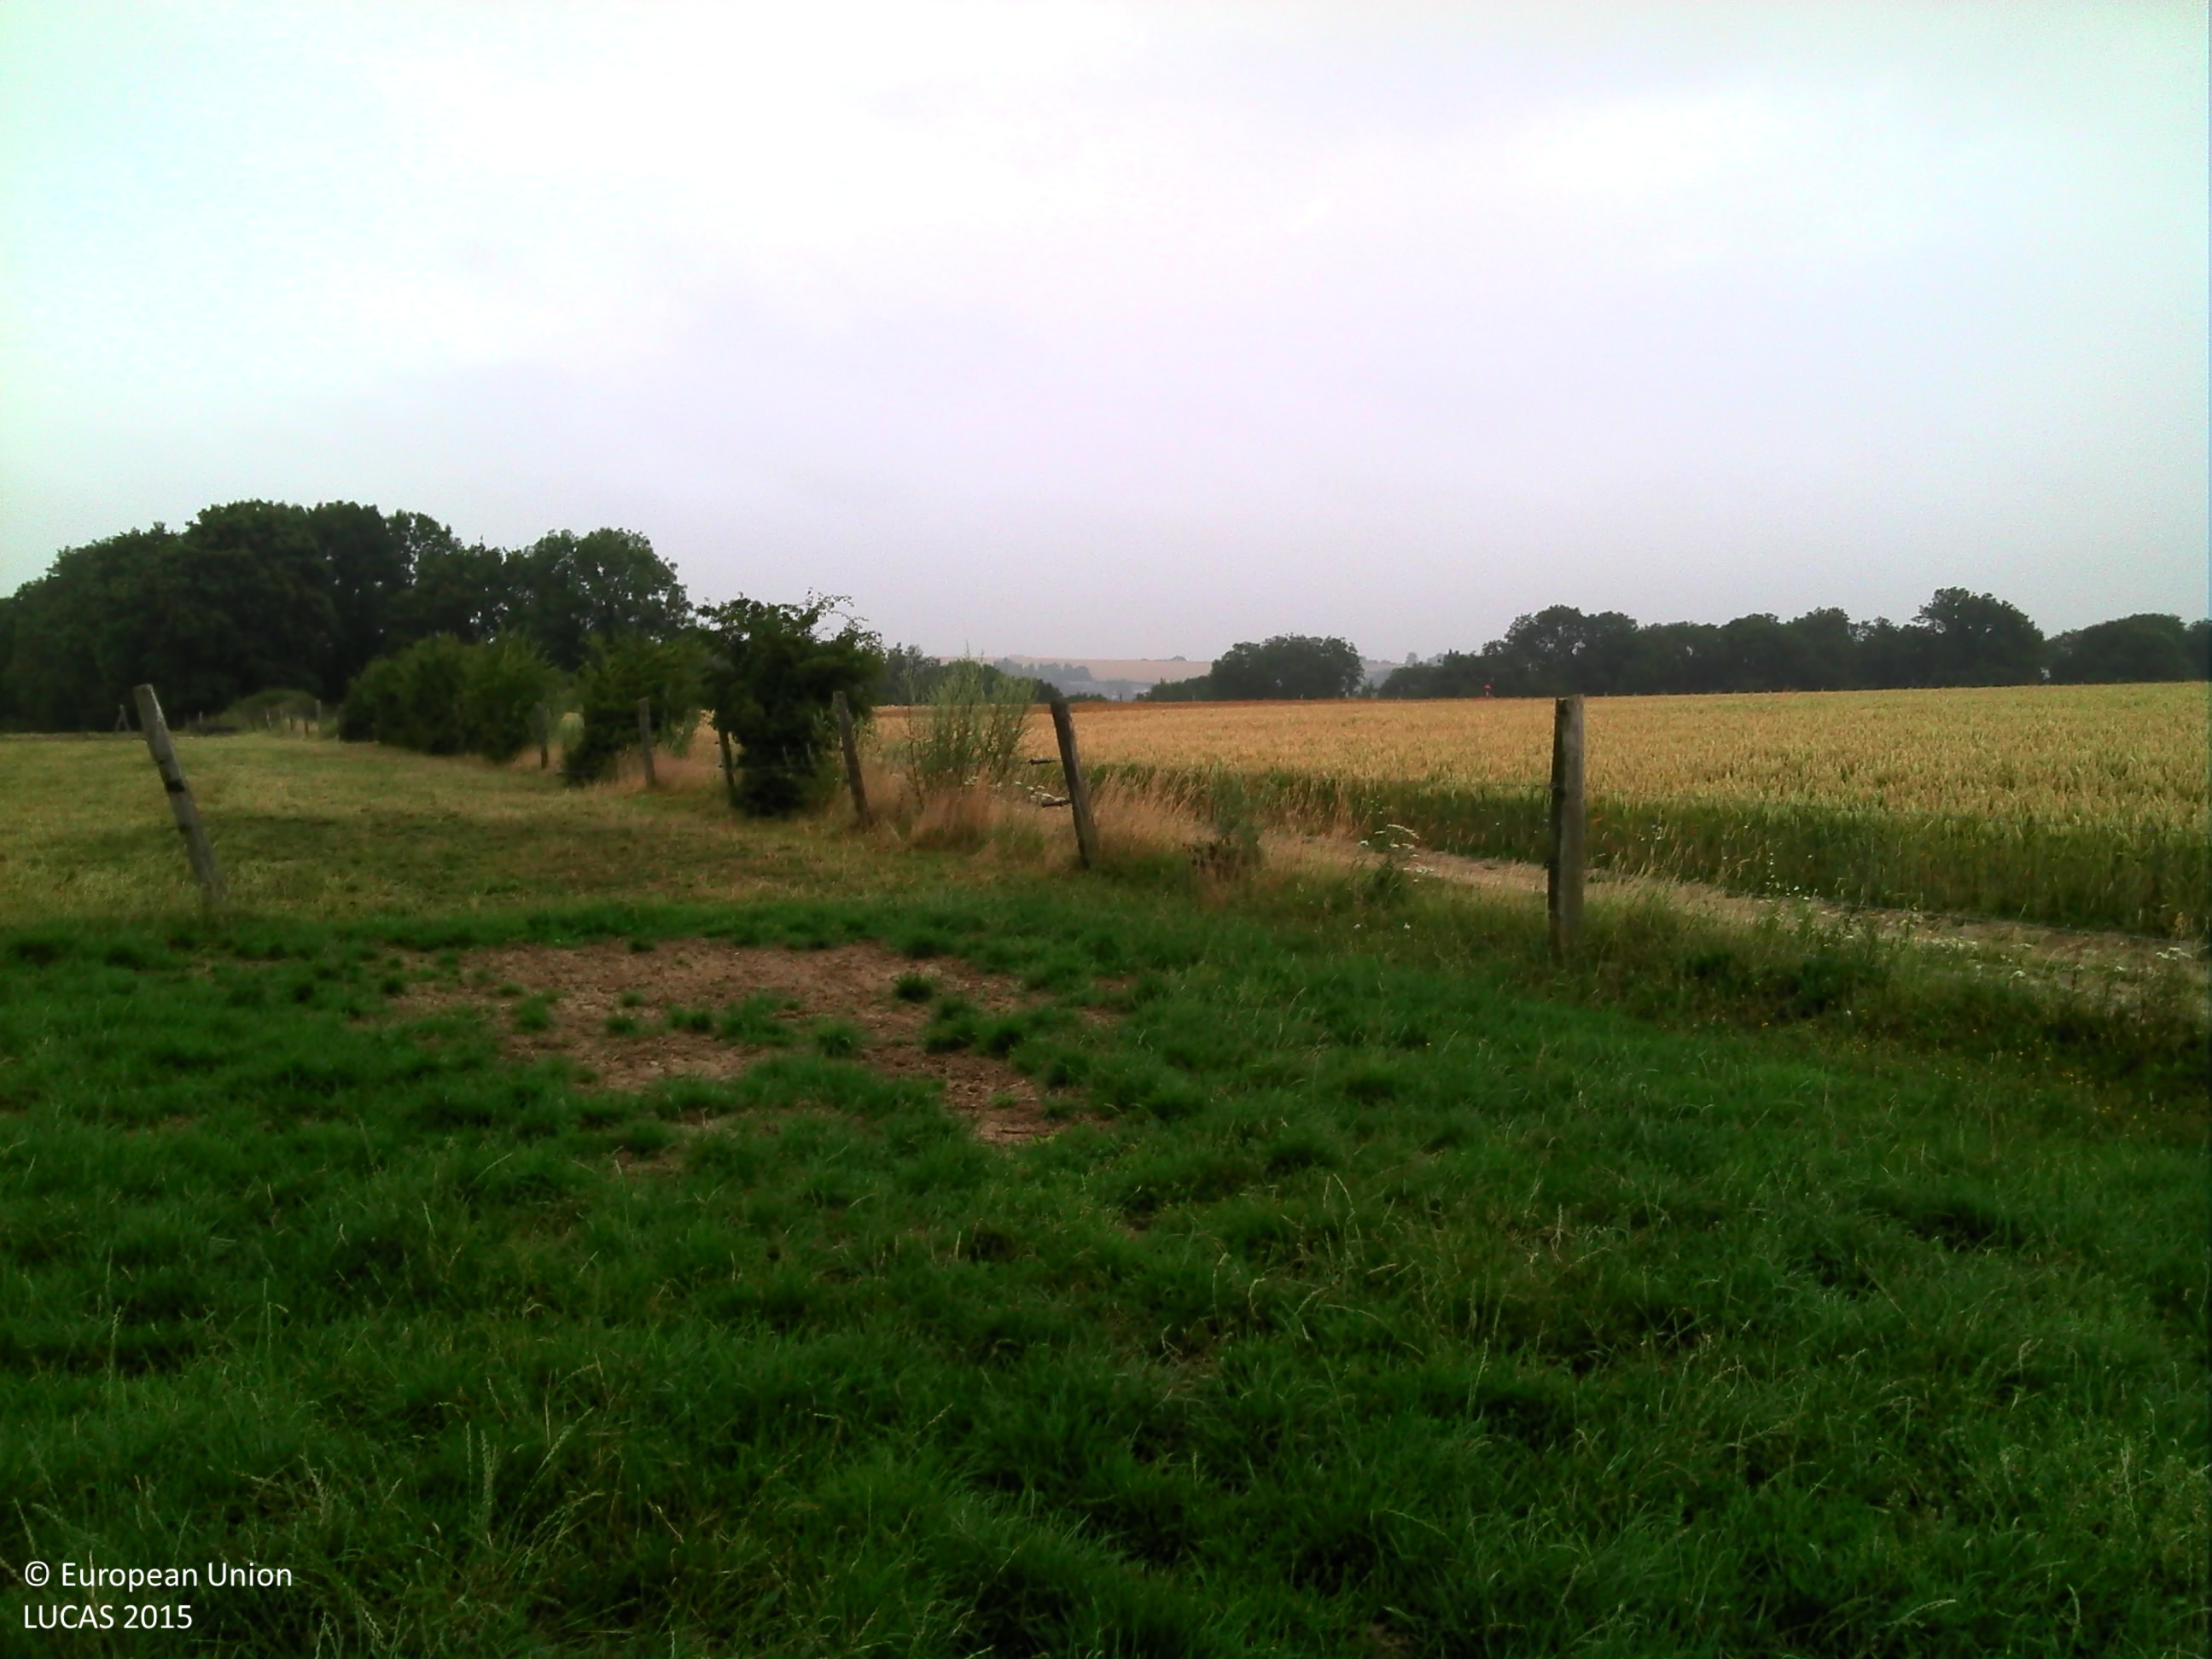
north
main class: Grassland
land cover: Grassland without tree/shrub cover
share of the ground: > 75 %
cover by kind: herbaceous plants 100 %
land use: Agriculture (excluding fallow land and kitchen gardens)
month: July
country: BE
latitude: 50.7473
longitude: 5.5906
